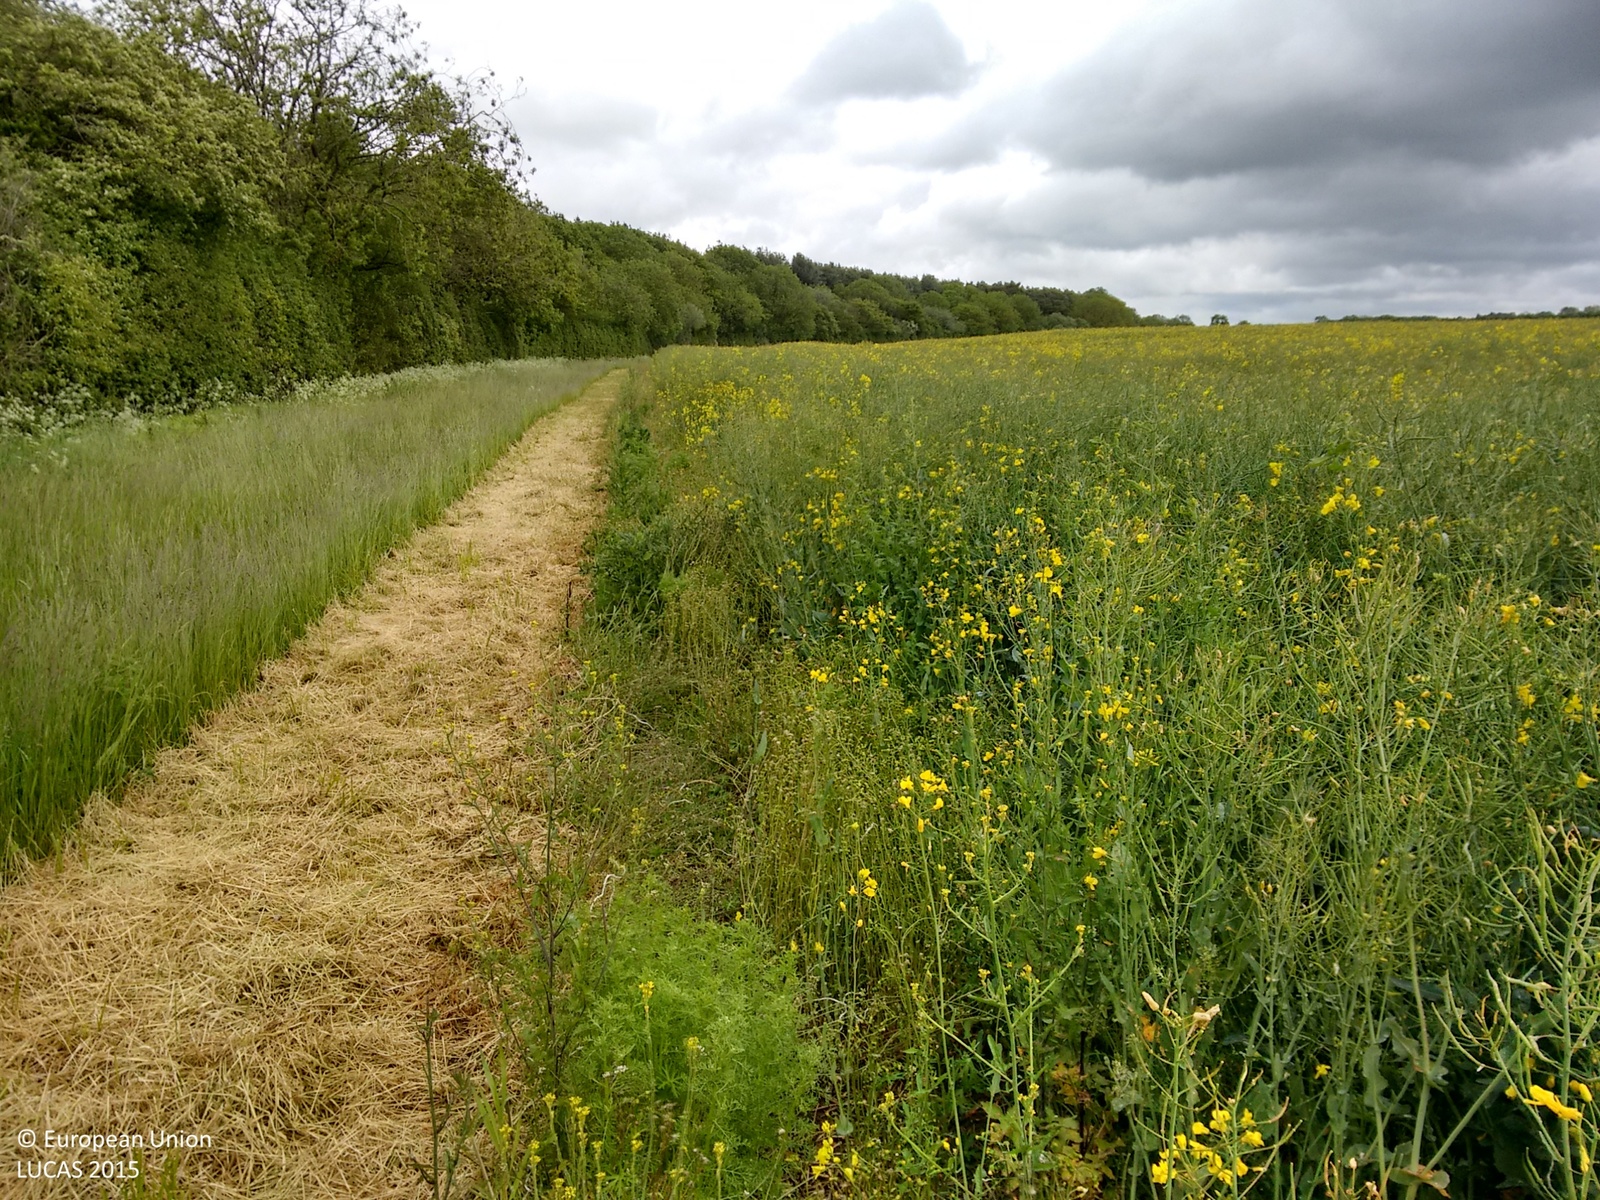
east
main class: Cropland
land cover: Rape and turnip rape
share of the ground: > 75 %
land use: Agriculture (excluding fallow land and kitchen gardens)
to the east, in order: Rape and turnip rape
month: June
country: GB
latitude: 53.2768
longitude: -0.2171
